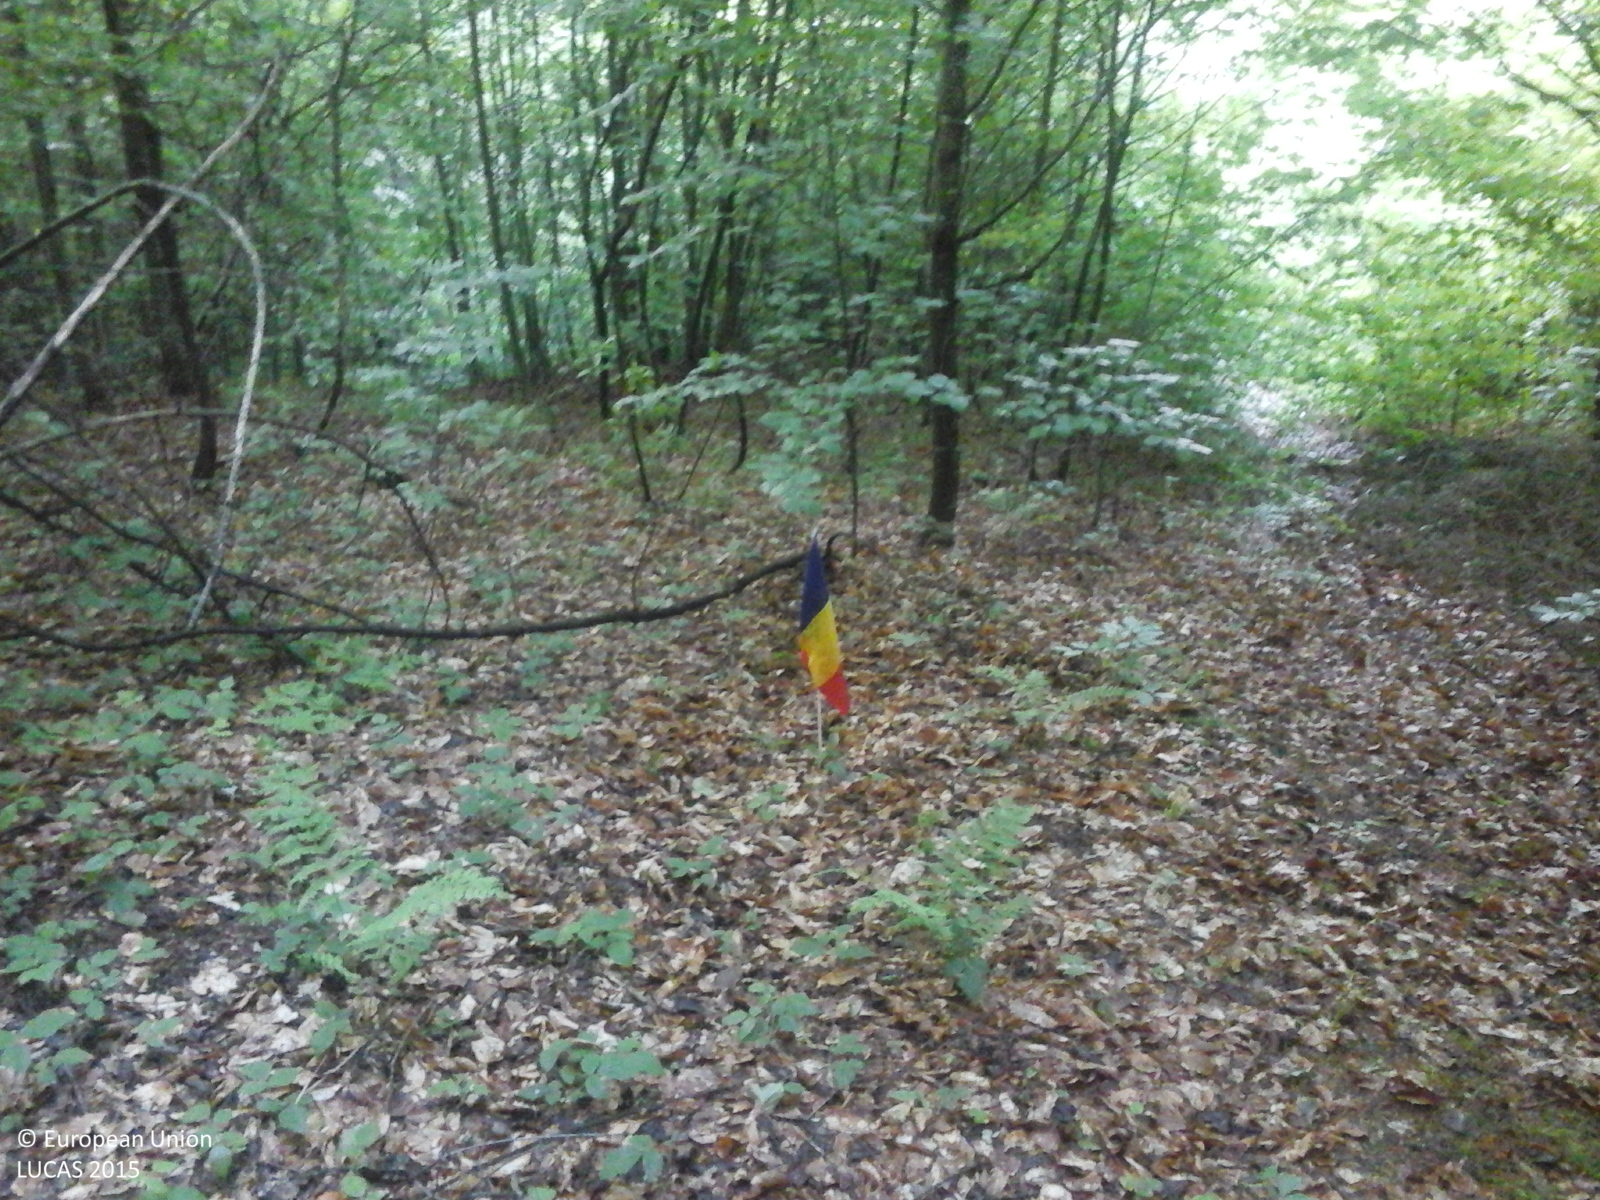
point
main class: Woodland
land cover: Broadleaved woodland
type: beech forest
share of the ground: > 75 %
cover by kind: broadleaved forest trees 85 %, coniferous forest trees 15 %
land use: Forestry
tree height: > 5 m
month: May
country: RO
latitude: 45.8422
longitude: 25.3320
